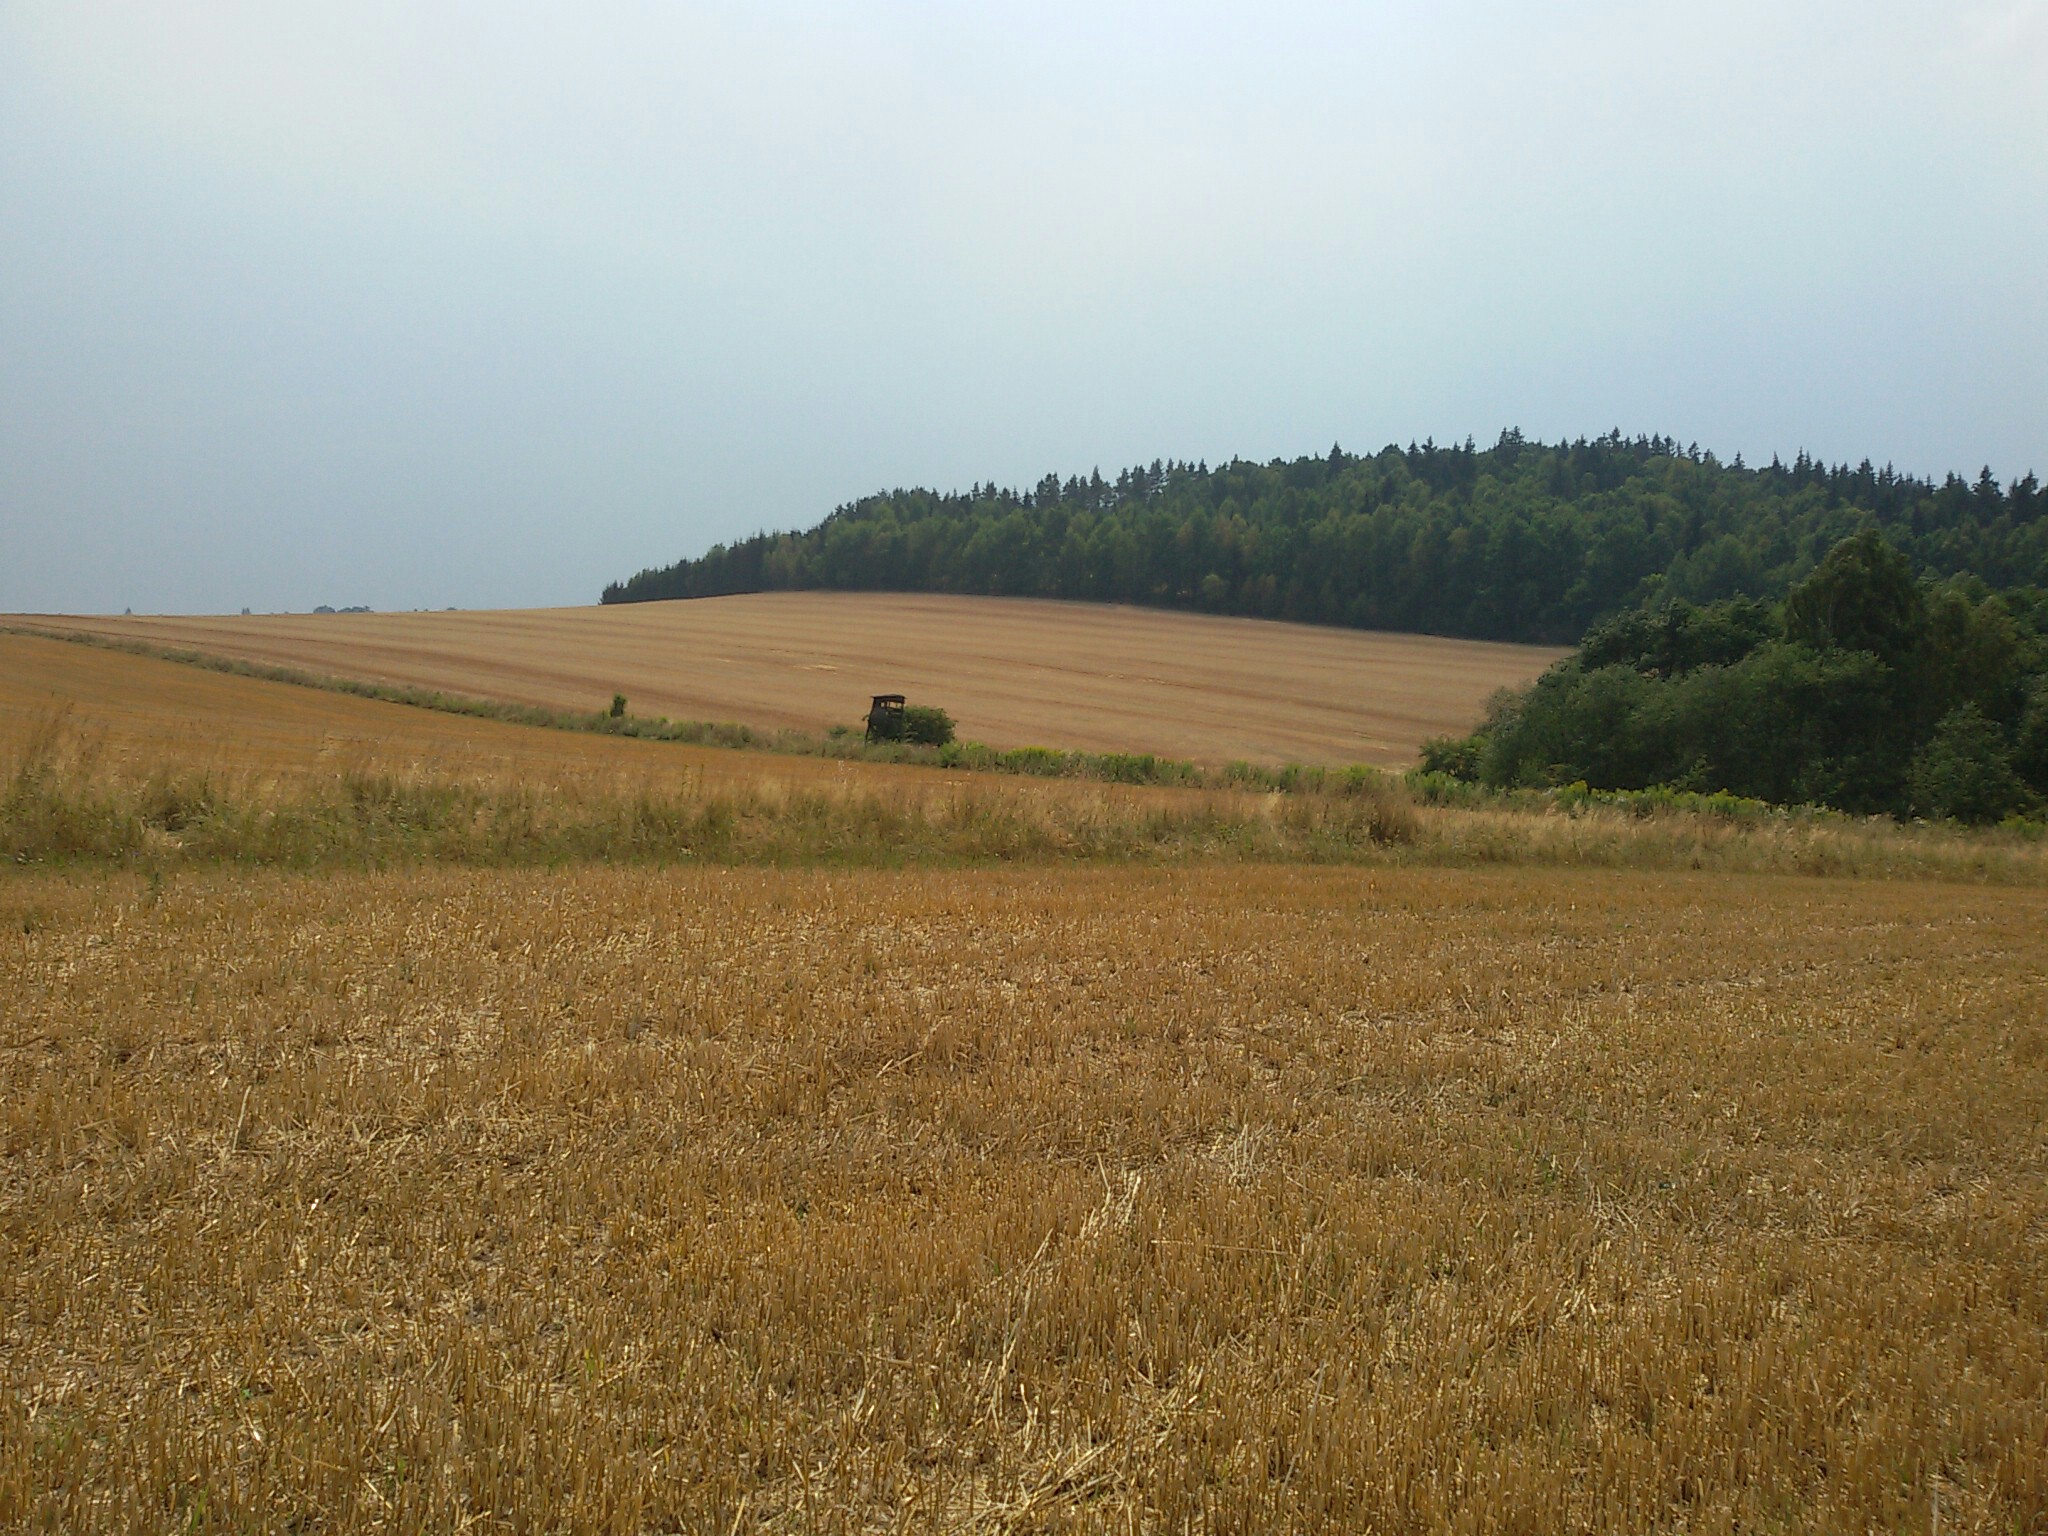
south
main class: Cropland
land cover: Triticale
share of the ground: > 75 %
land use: Agriculture (excluding fallow land and kitchen gardens)
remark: Harvested field
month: August
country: PL
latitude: 51.0334
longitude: 15.6946
